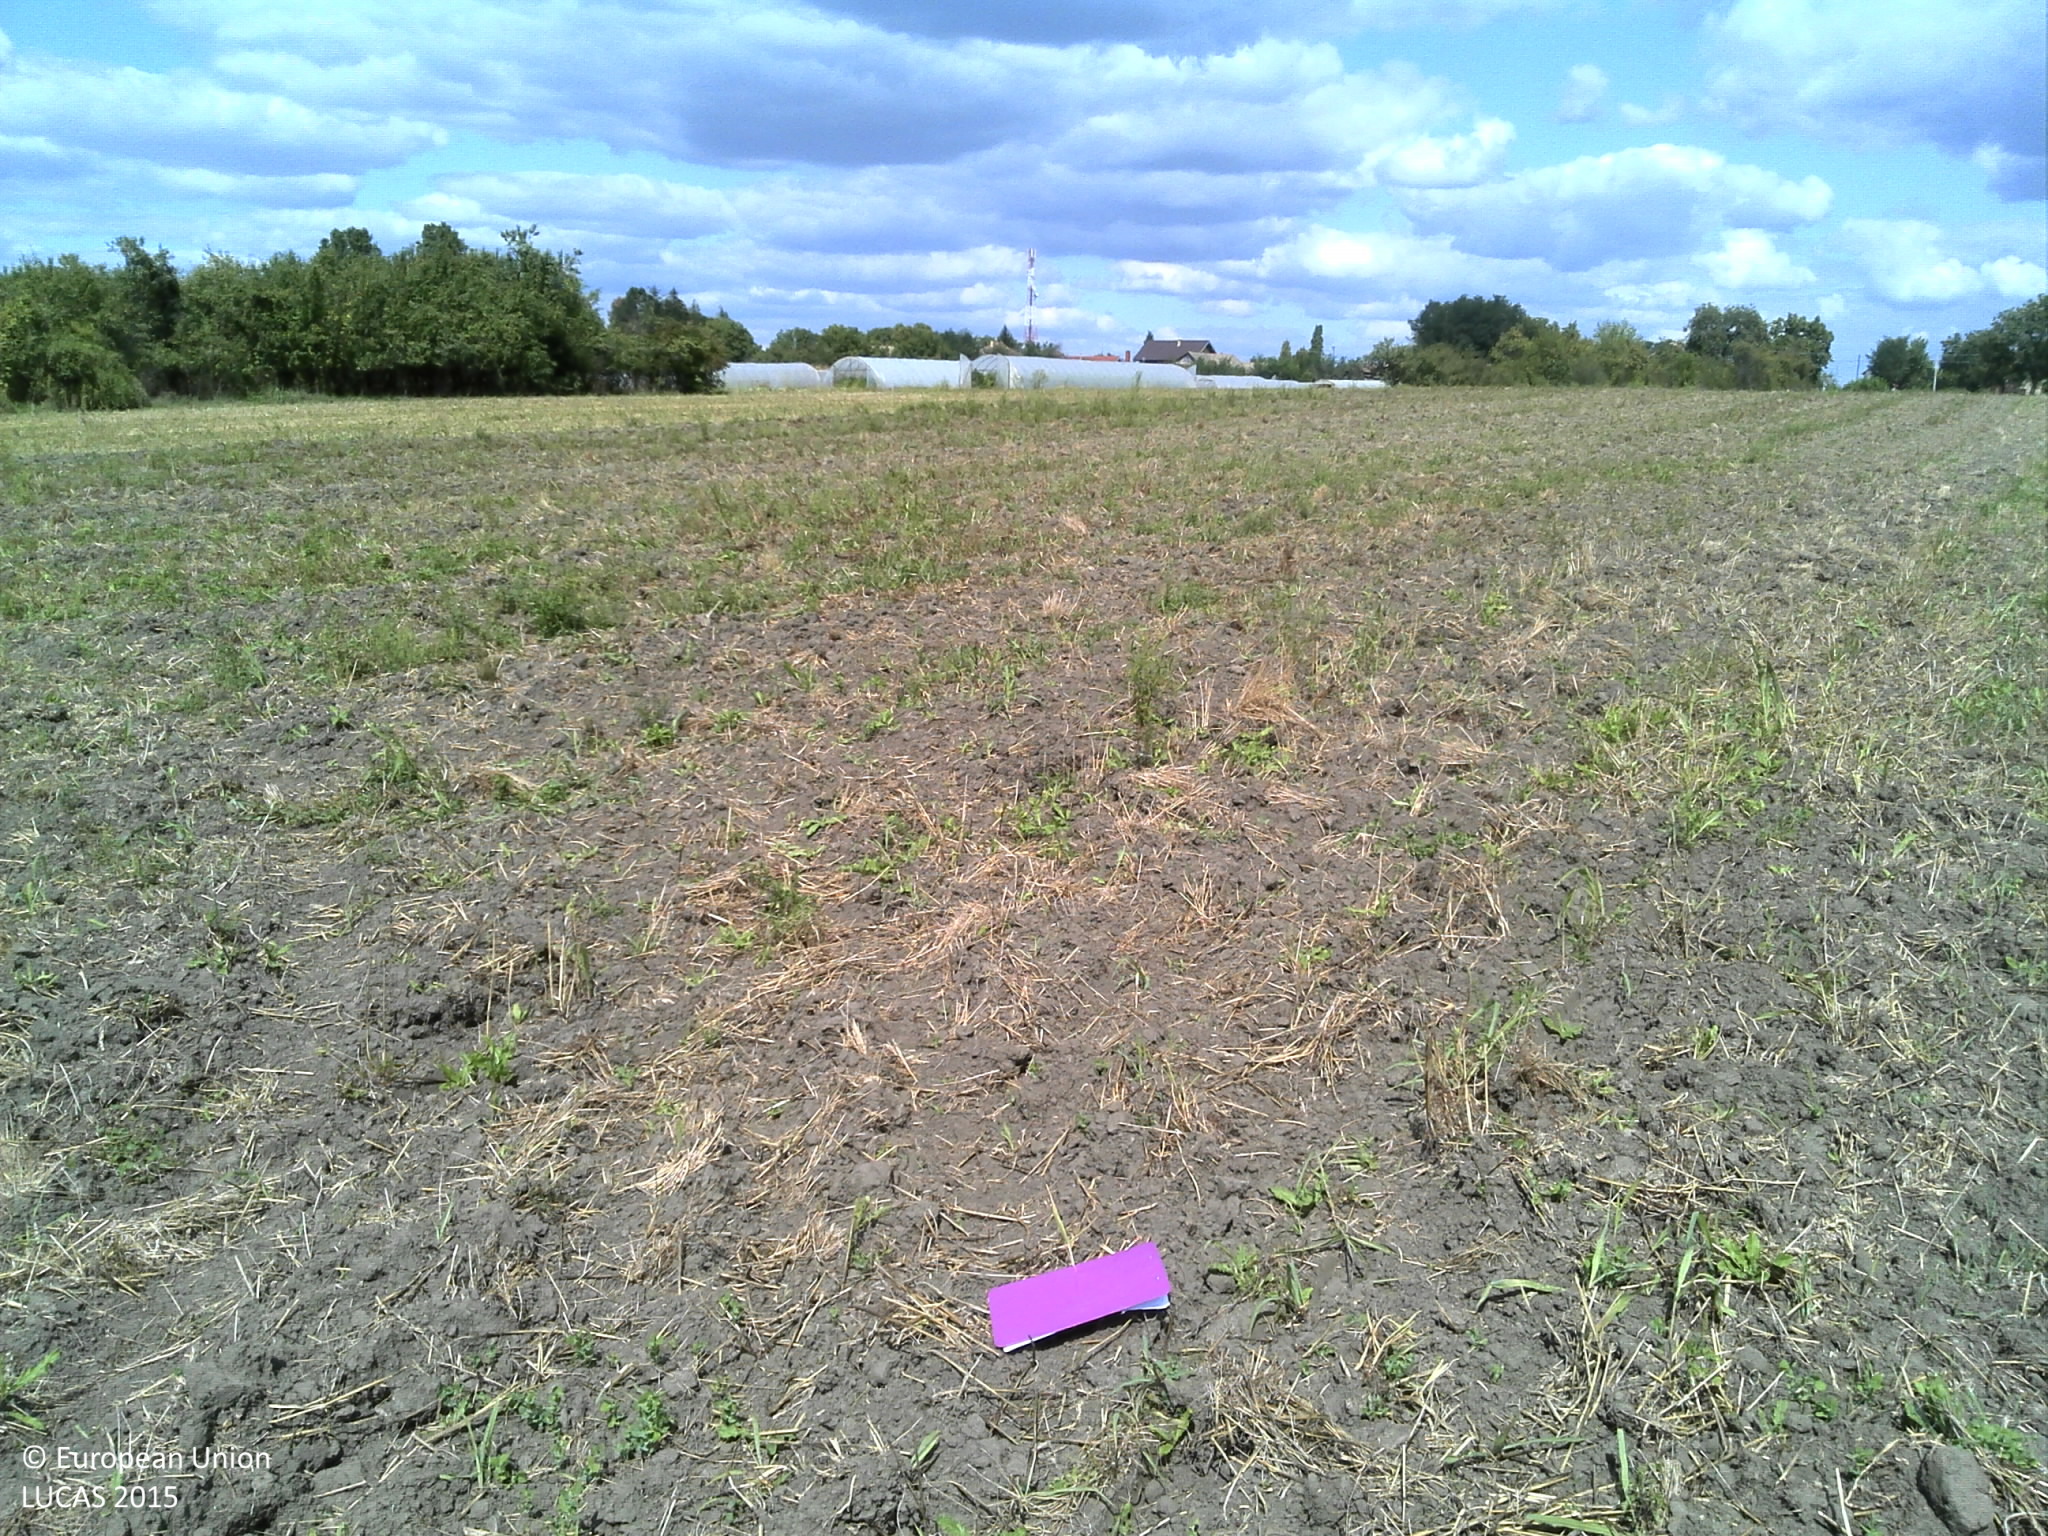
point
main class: Cropland
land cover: Barley
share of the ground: > 75 %
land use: Agriculture (excluding fallow land and kitchen gardens)
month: September
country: HR
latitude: 45.6965
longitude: 18.5993
